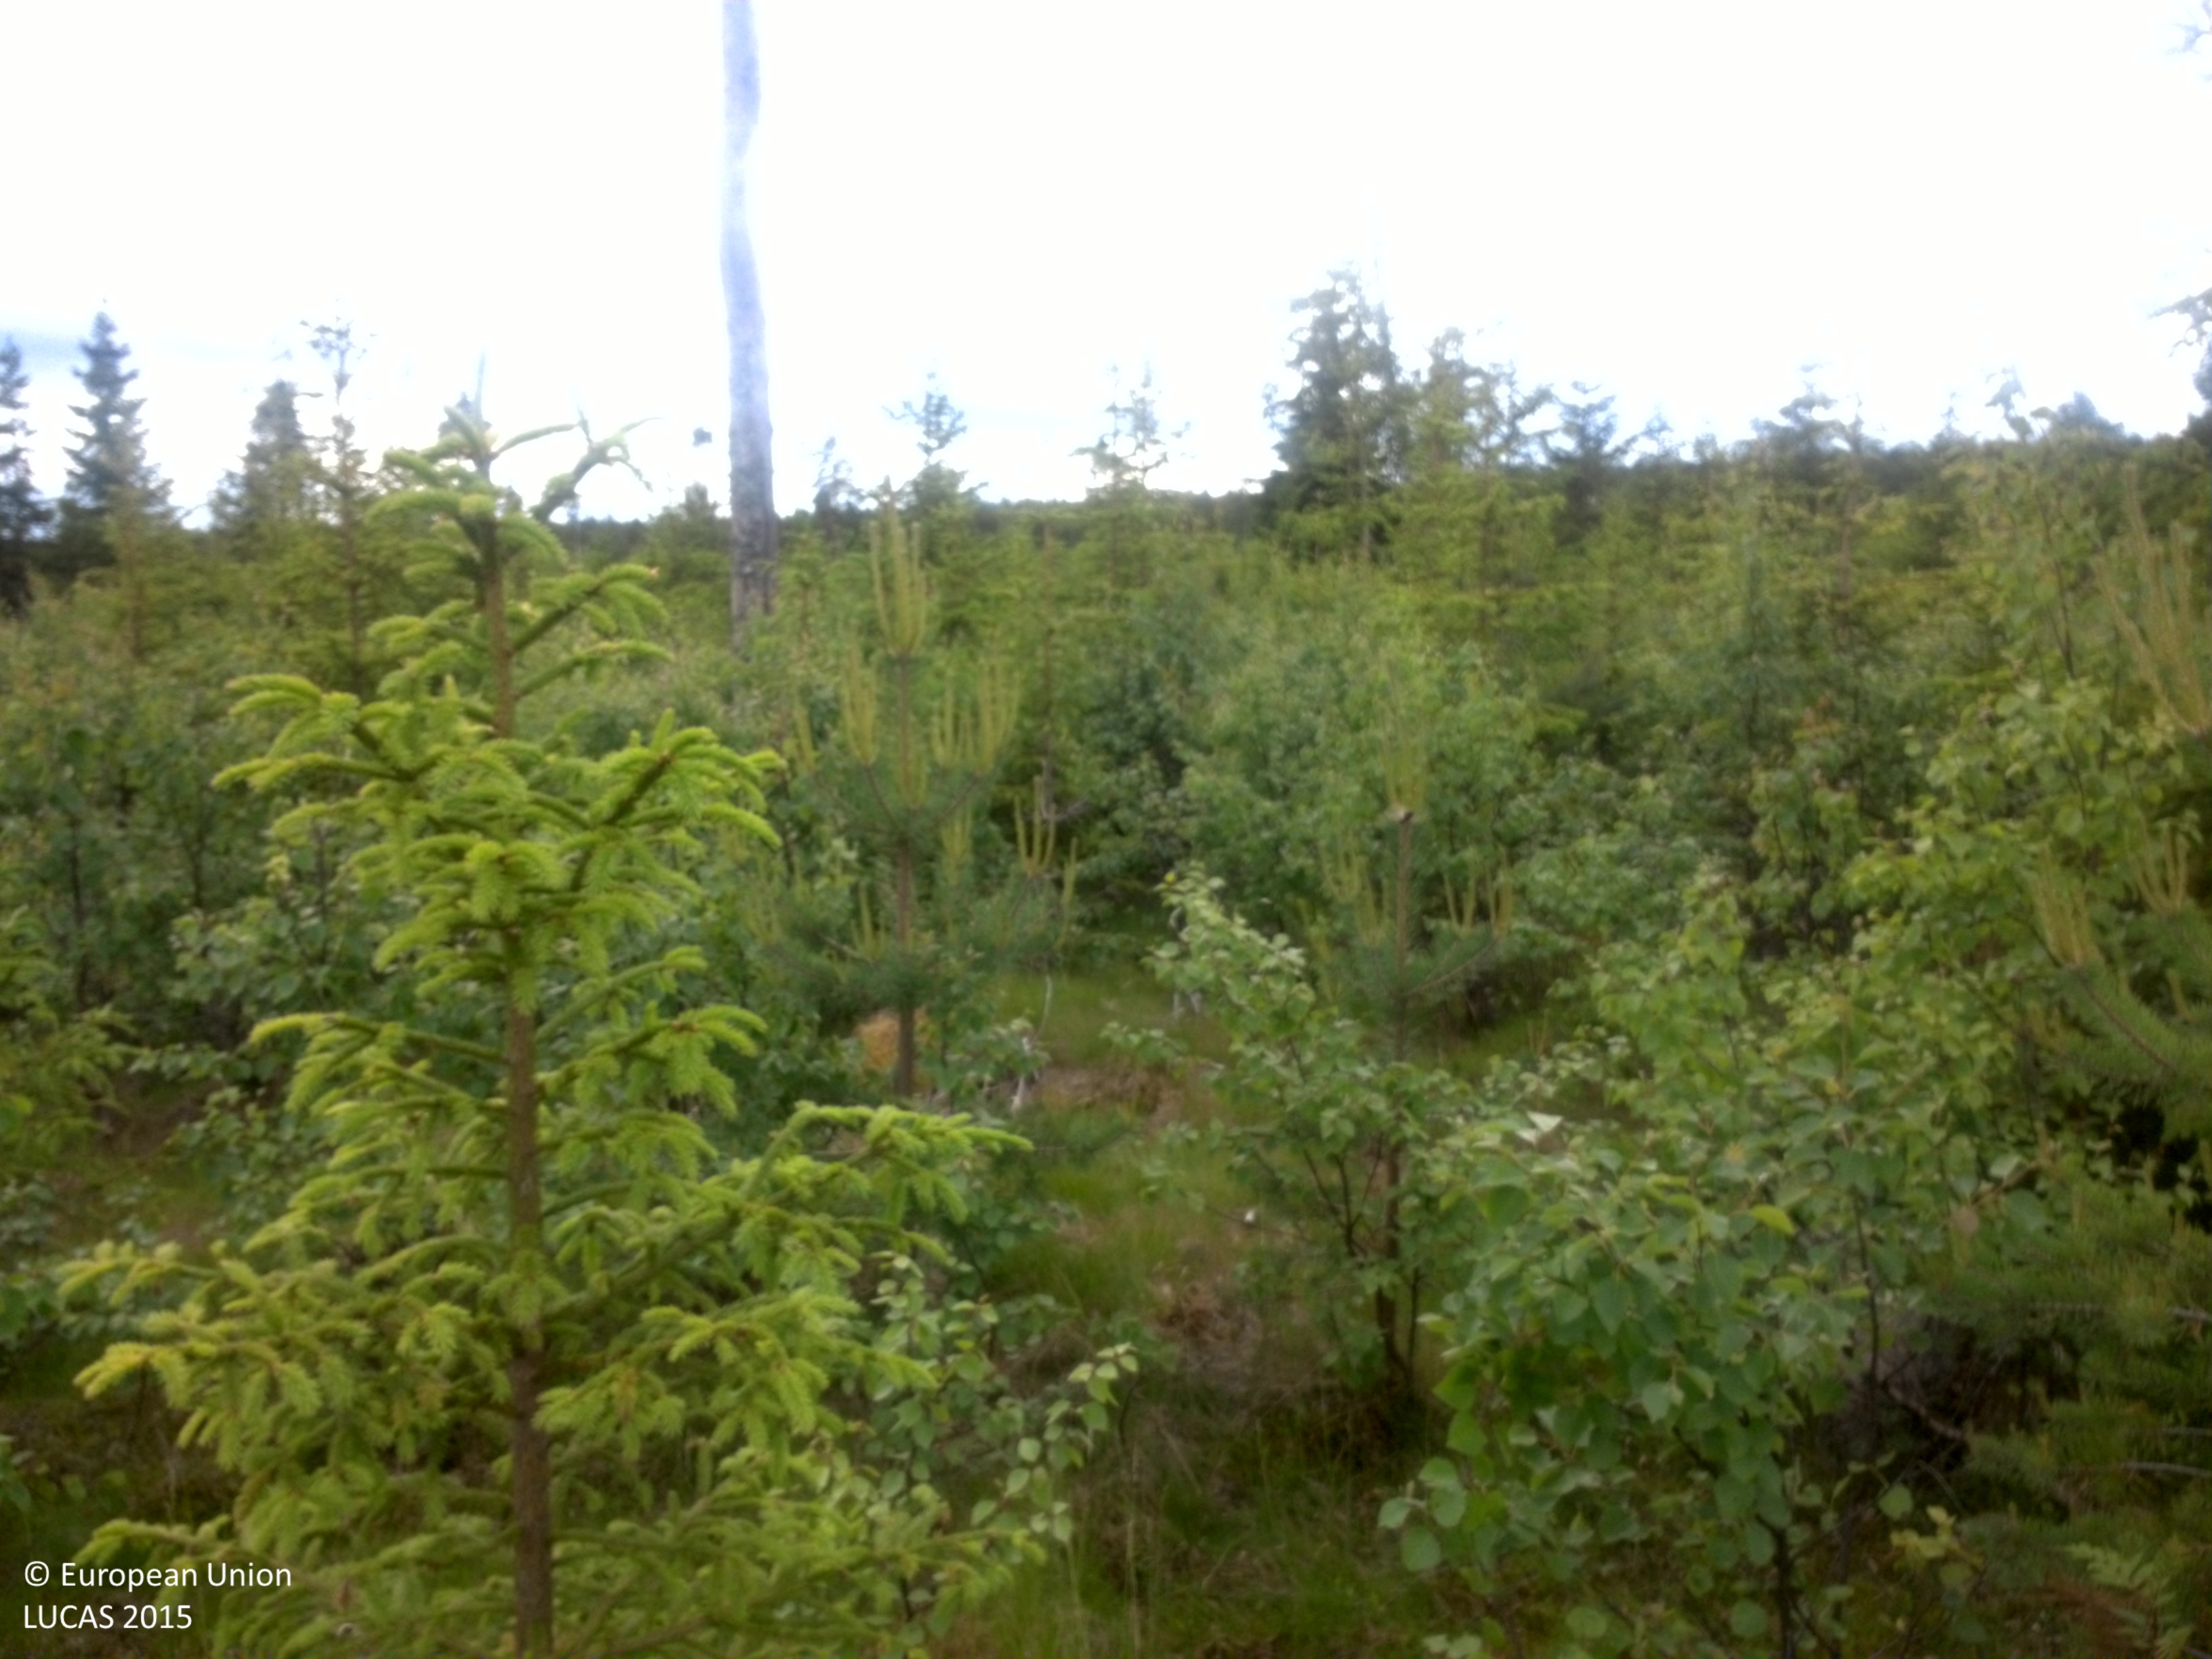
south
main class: Woodland
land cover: Other mixed woodland
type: boreal forest
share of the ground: > 75 %
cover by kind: coniferous forest trees 40 %, broadleaved forest trees 40 %, shrubs 10 %, herbaceous plants 10 %
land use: Forestry
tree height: < 5 m
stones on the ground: 25 - 50 %
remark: Clear cut
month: July
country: SE
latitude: 64.6262
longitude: 20.3277
